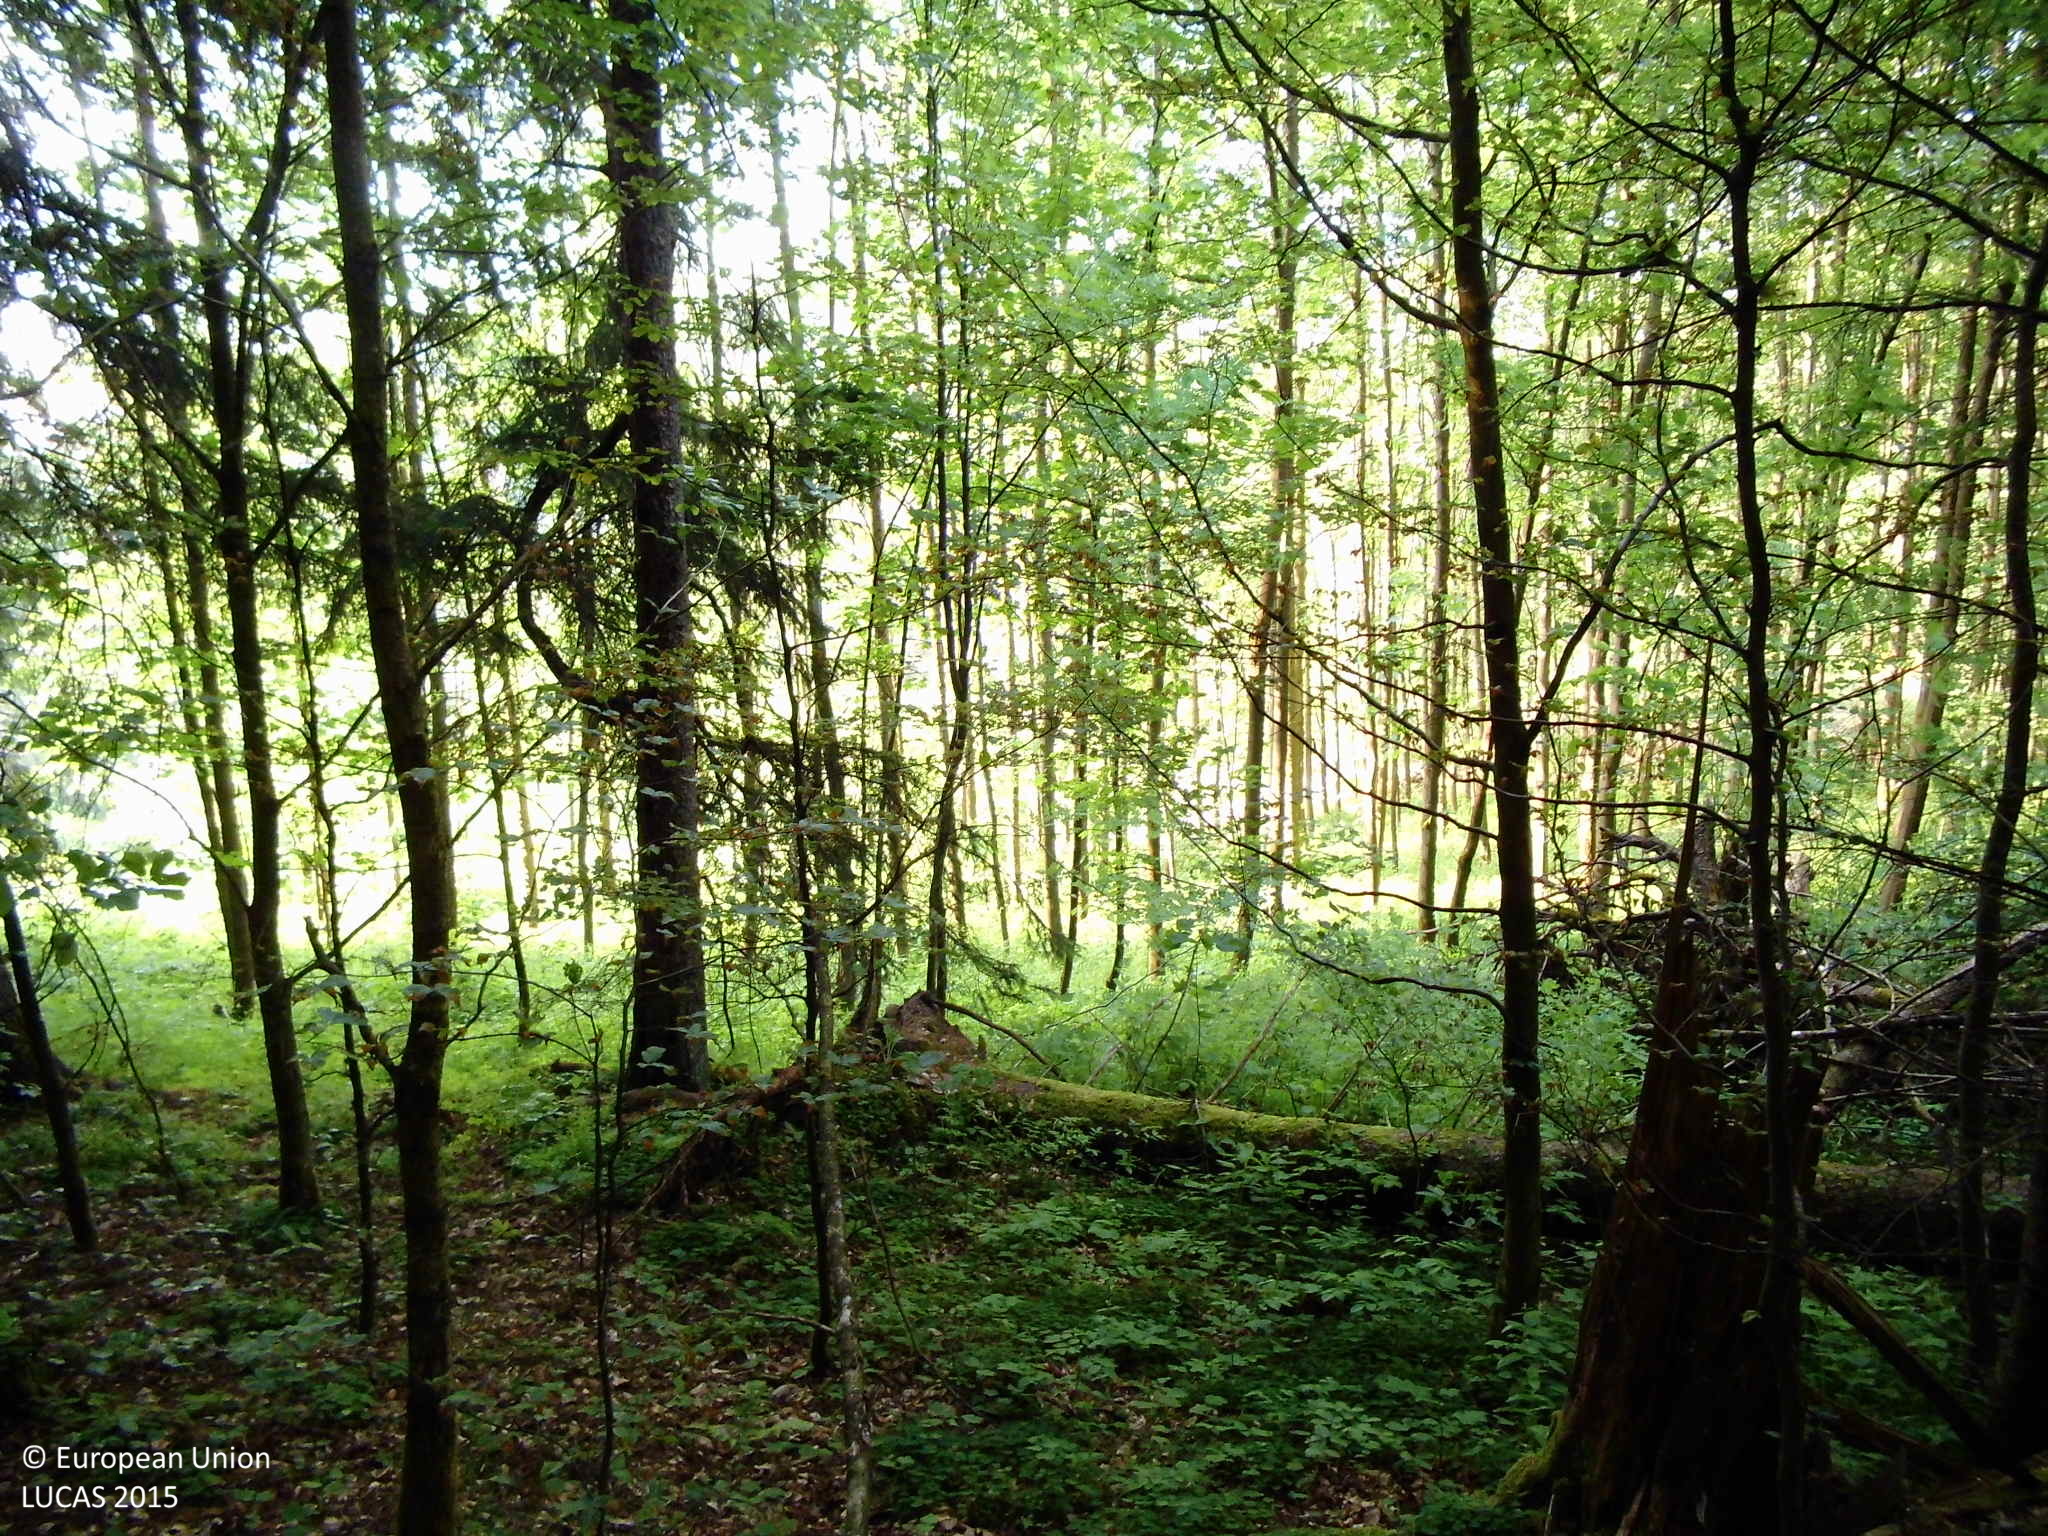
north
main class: Woodland
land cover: Spruce dominated mixed woodland
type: hemiboreal forest and nemoral coniferous forest and mixed broadleaved-coniferous forest
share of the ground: > 75 %
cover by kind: broadleaved forest trees 50 %, coniferous forest trees 45 %, herbaceous plants 5 %
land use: Forestry
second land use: Amenities, museums, leisure
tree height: > 5 m
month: June
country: DE
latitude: 50.9106
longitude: 8.4217
